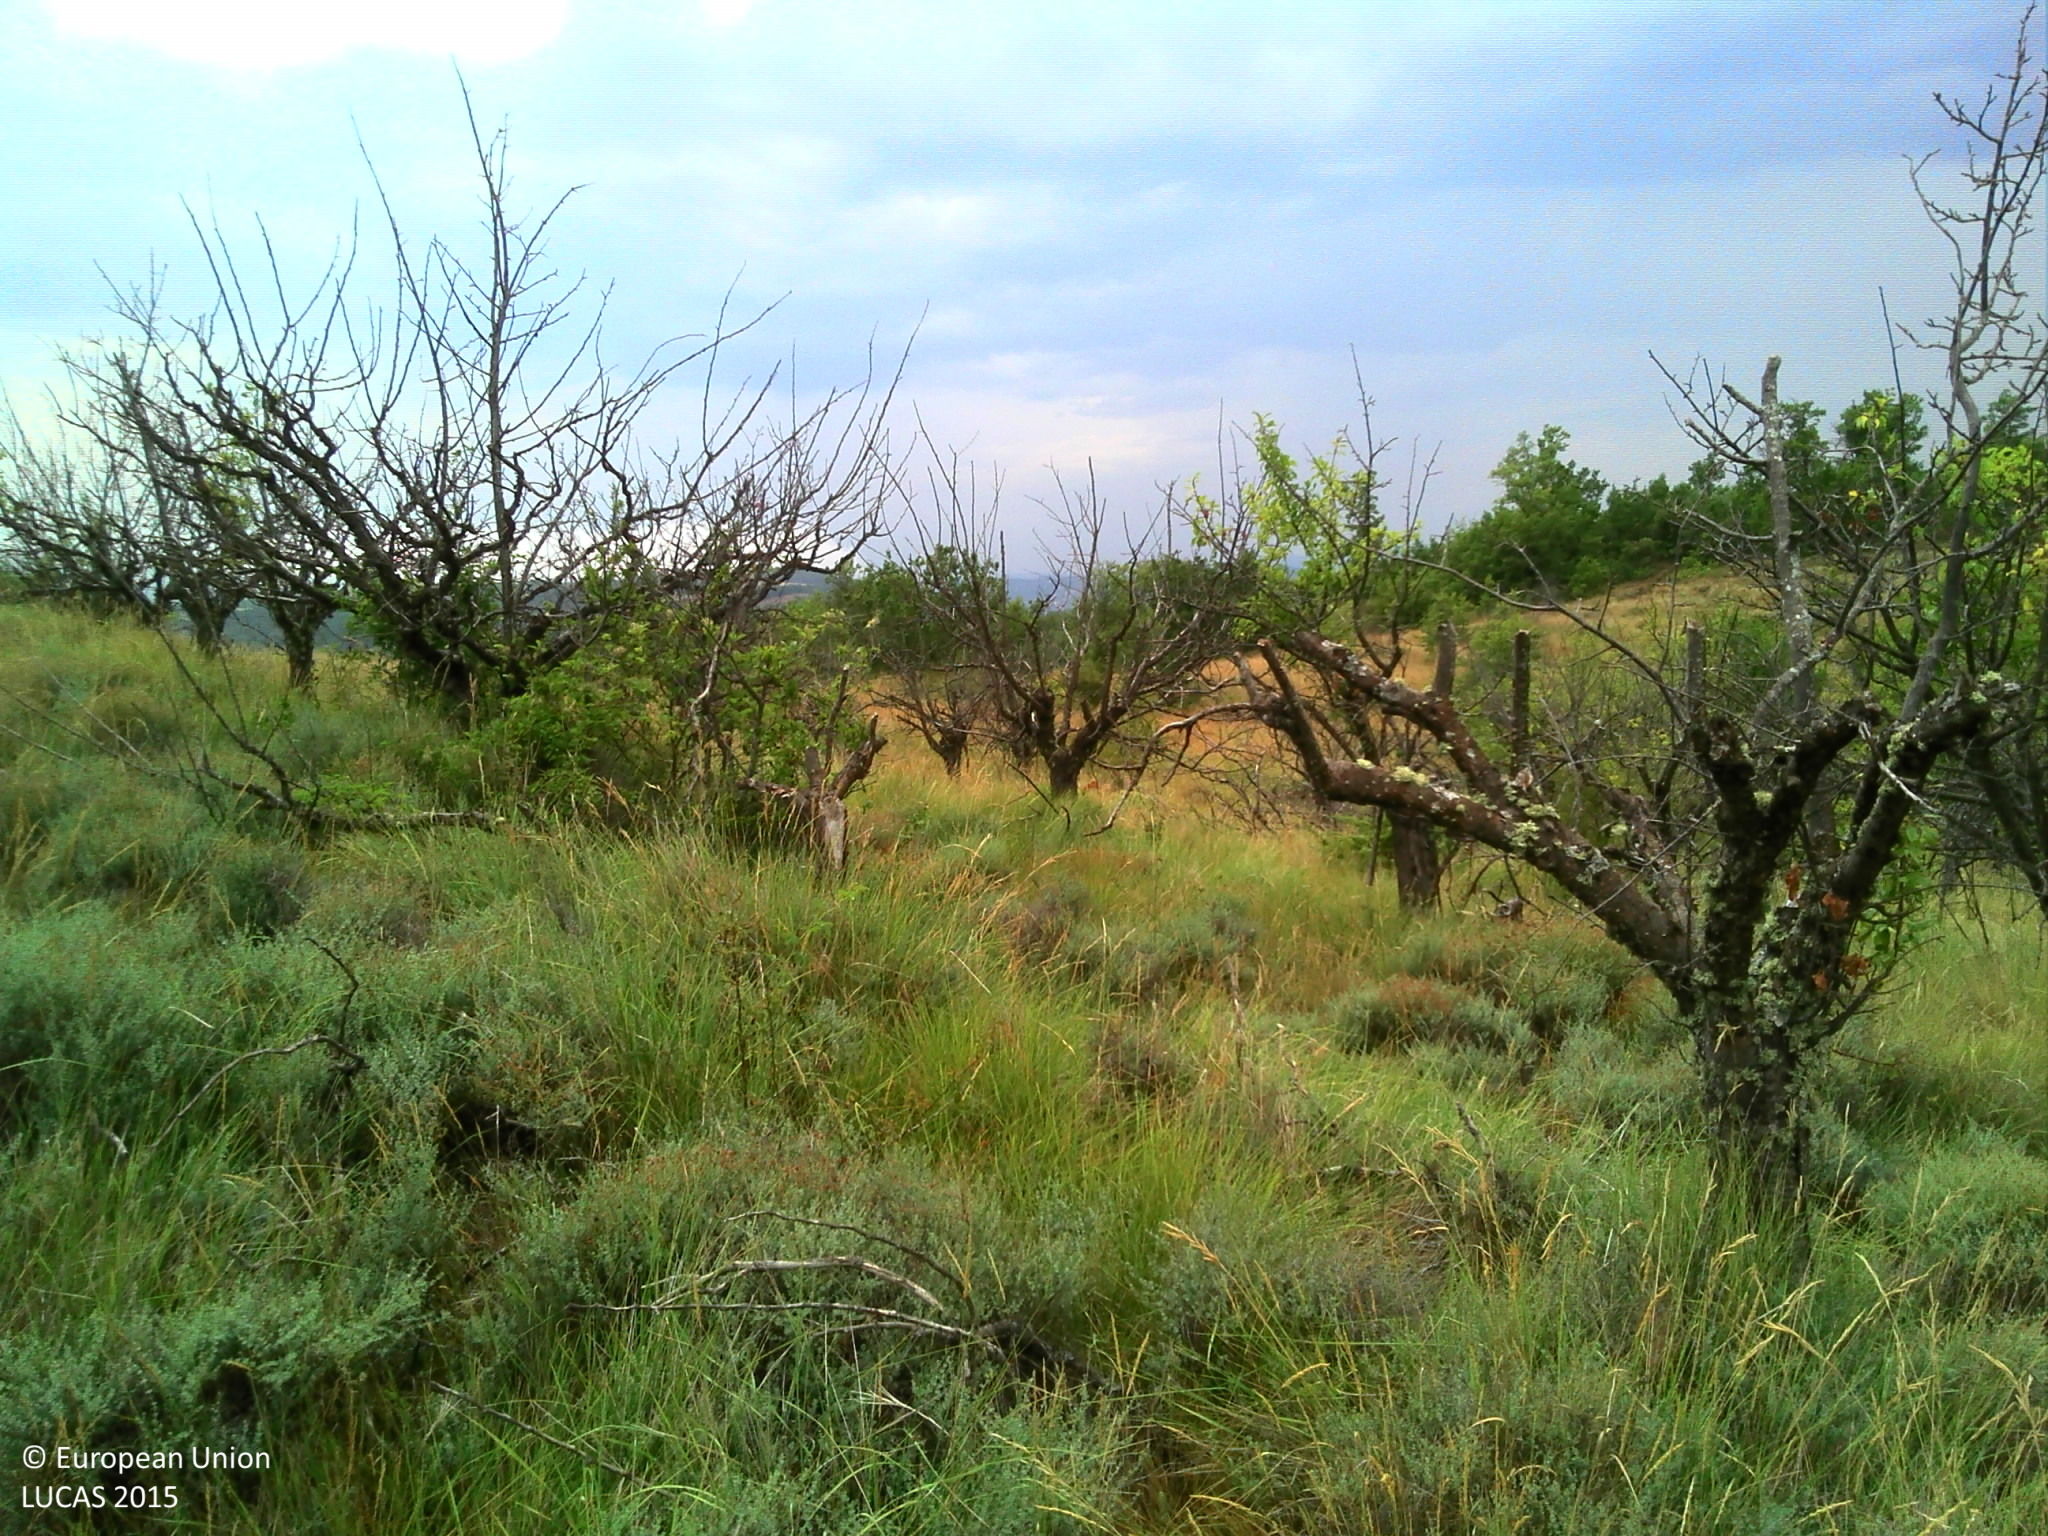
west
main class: Cropland
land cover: Other fruit trees and berries
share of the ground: 25 - 50 %
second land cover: Spontaneously vegetated surfaces
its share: 50 - 75 %
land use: Agriculture (excluding fallow land and kitchen gardens)
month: August
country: FR
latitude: 43.9114
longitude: 5.5381
